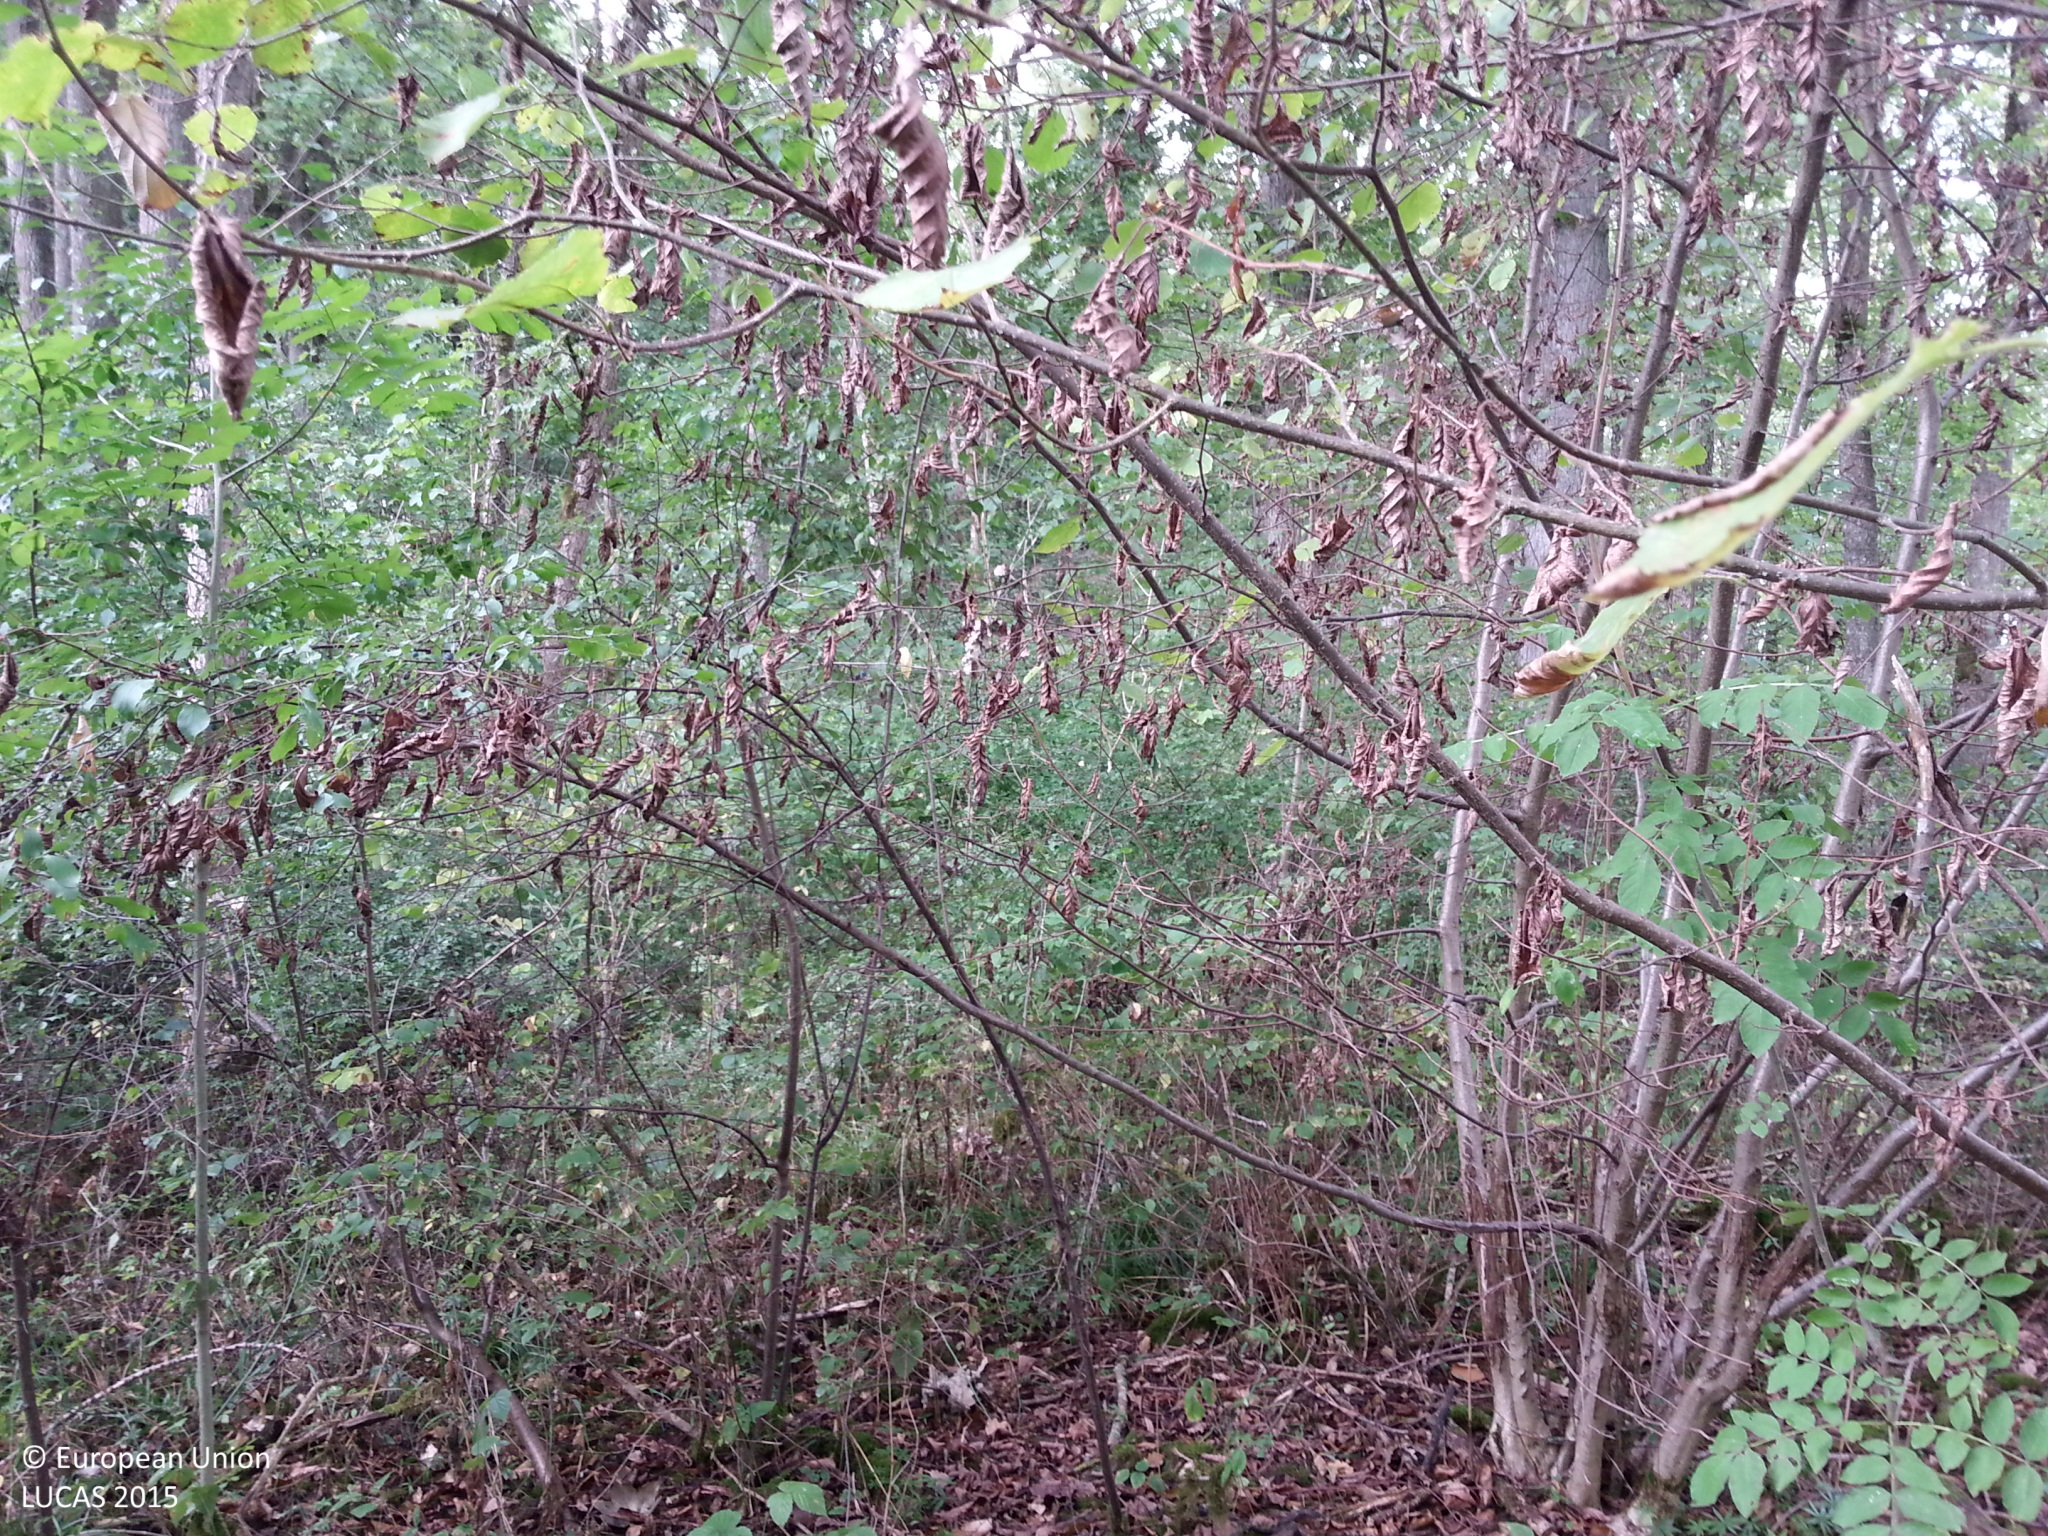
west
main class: Woodland
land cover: Broadleaved woodland
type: acidophilous oak and oak-birch forest
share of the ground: 50 - 75 %
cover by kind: broadleaved forest trees 70 %, shrubs 15 %, herbaceous plants 15 %
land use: Forestry
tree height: > 5 m
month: September
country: DE
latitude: 49.2850
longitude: 9.9038
